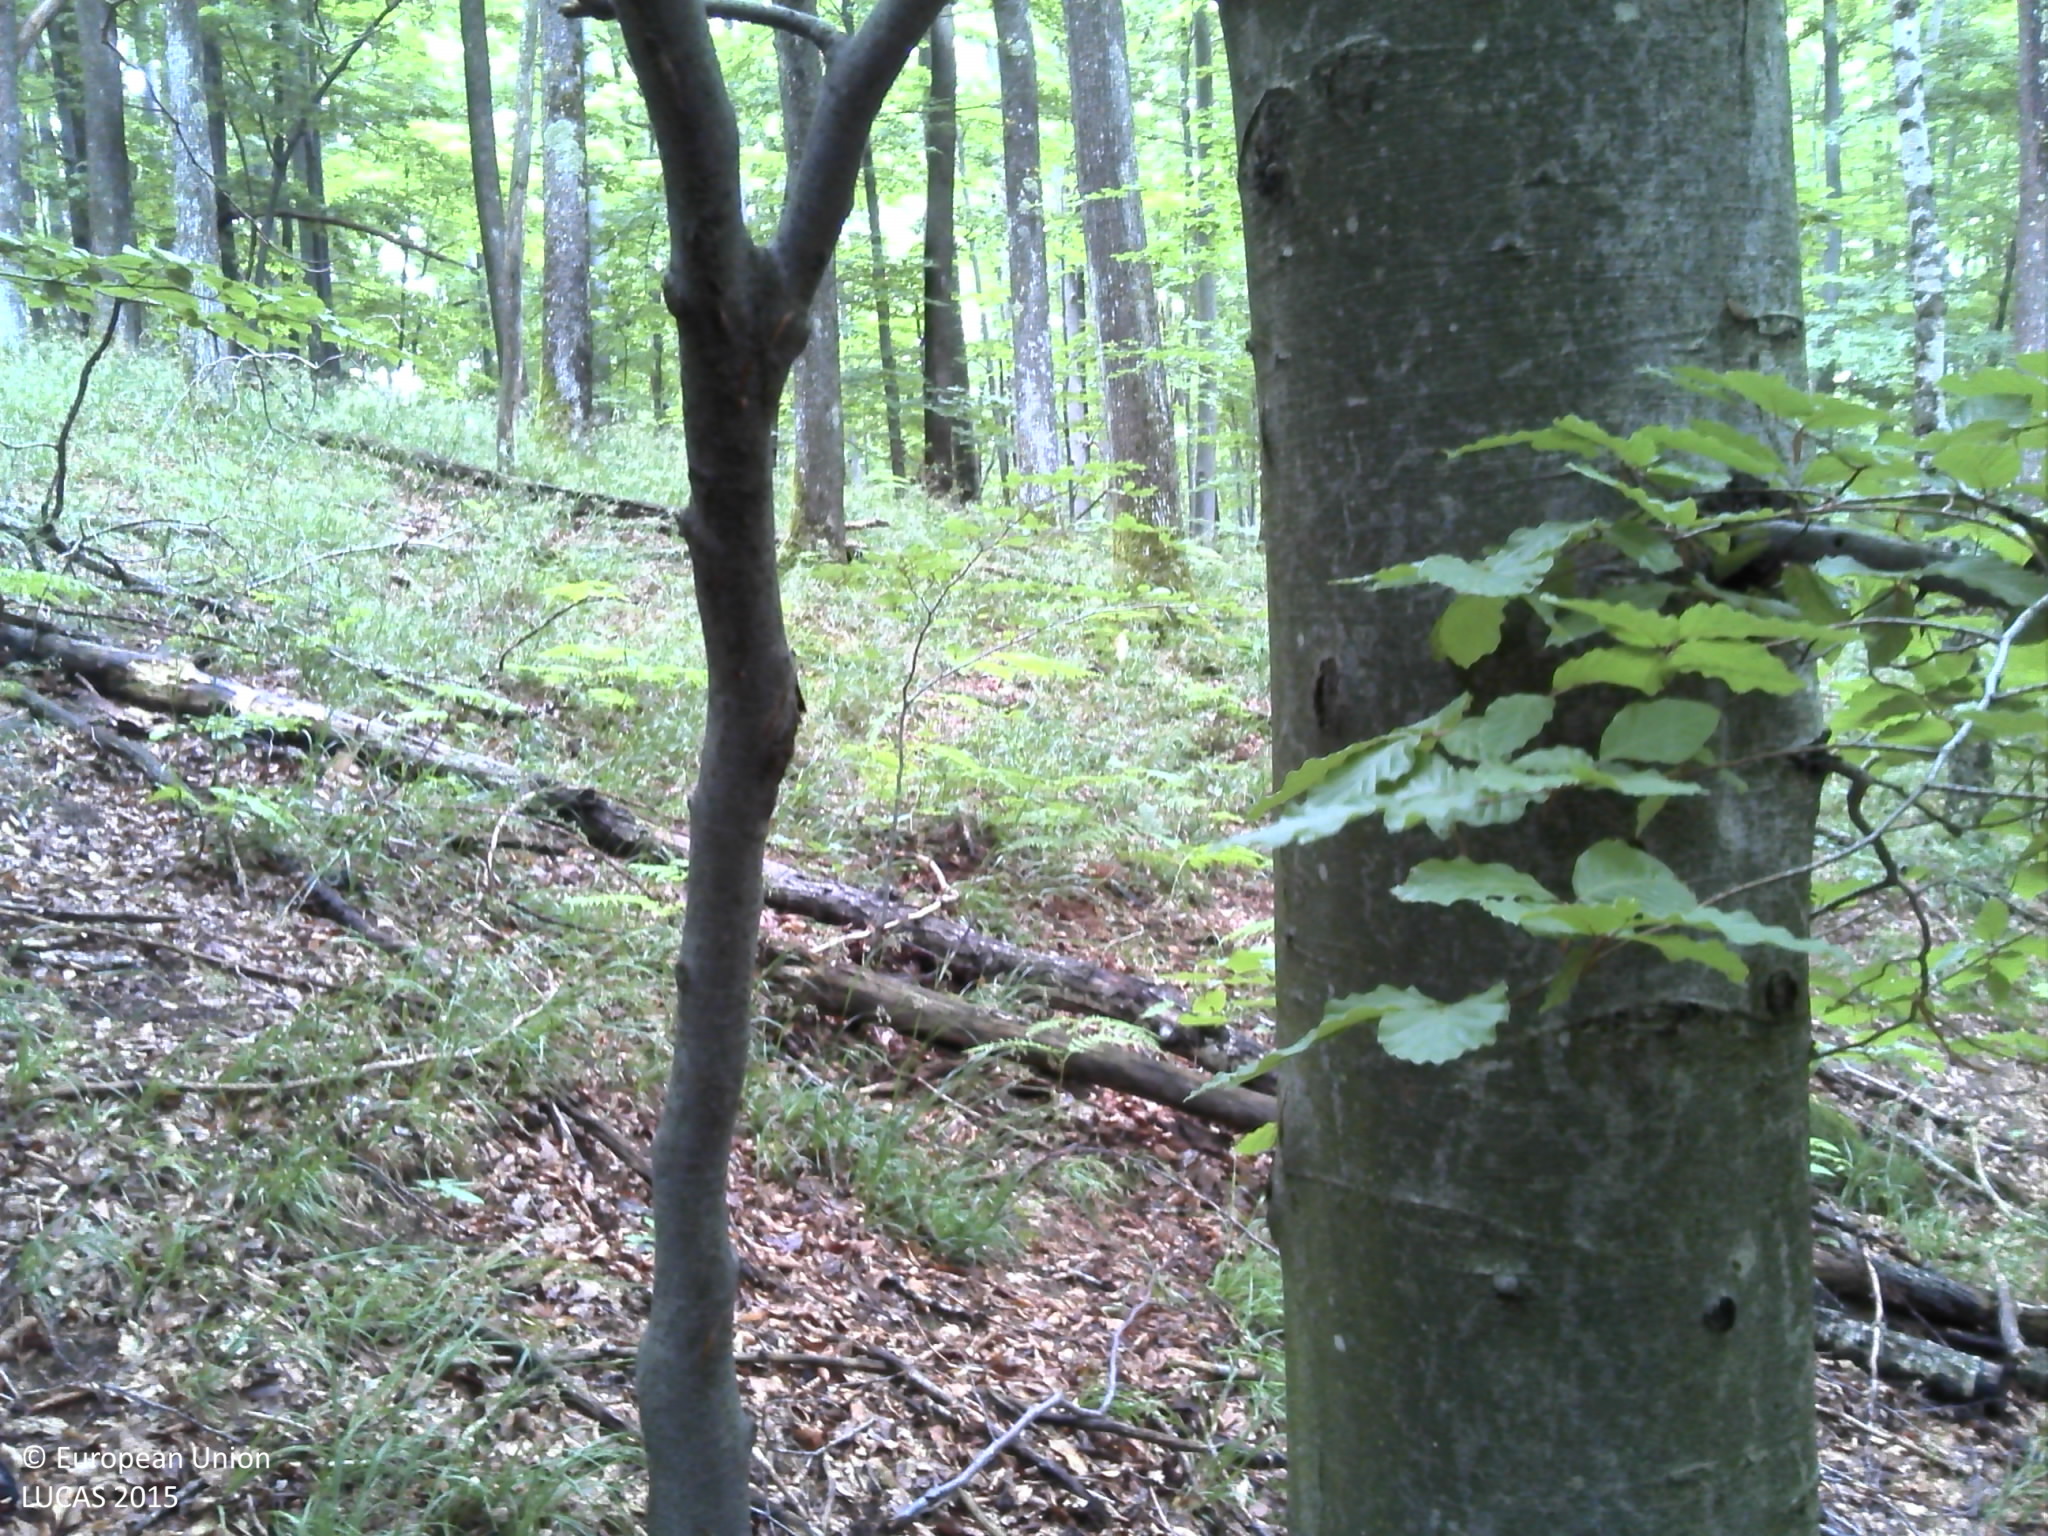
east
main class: Woodland
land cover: Broadleaved woodland
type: beech forest
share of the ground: > 75 %
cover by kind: broadleaved forest trees 80 %, lichens and mosses 20 %
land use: Forestry
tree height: > 5 m
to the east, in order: Broadleaved woodland
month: June
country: HR
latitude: 45.5293
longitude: 17.4664
